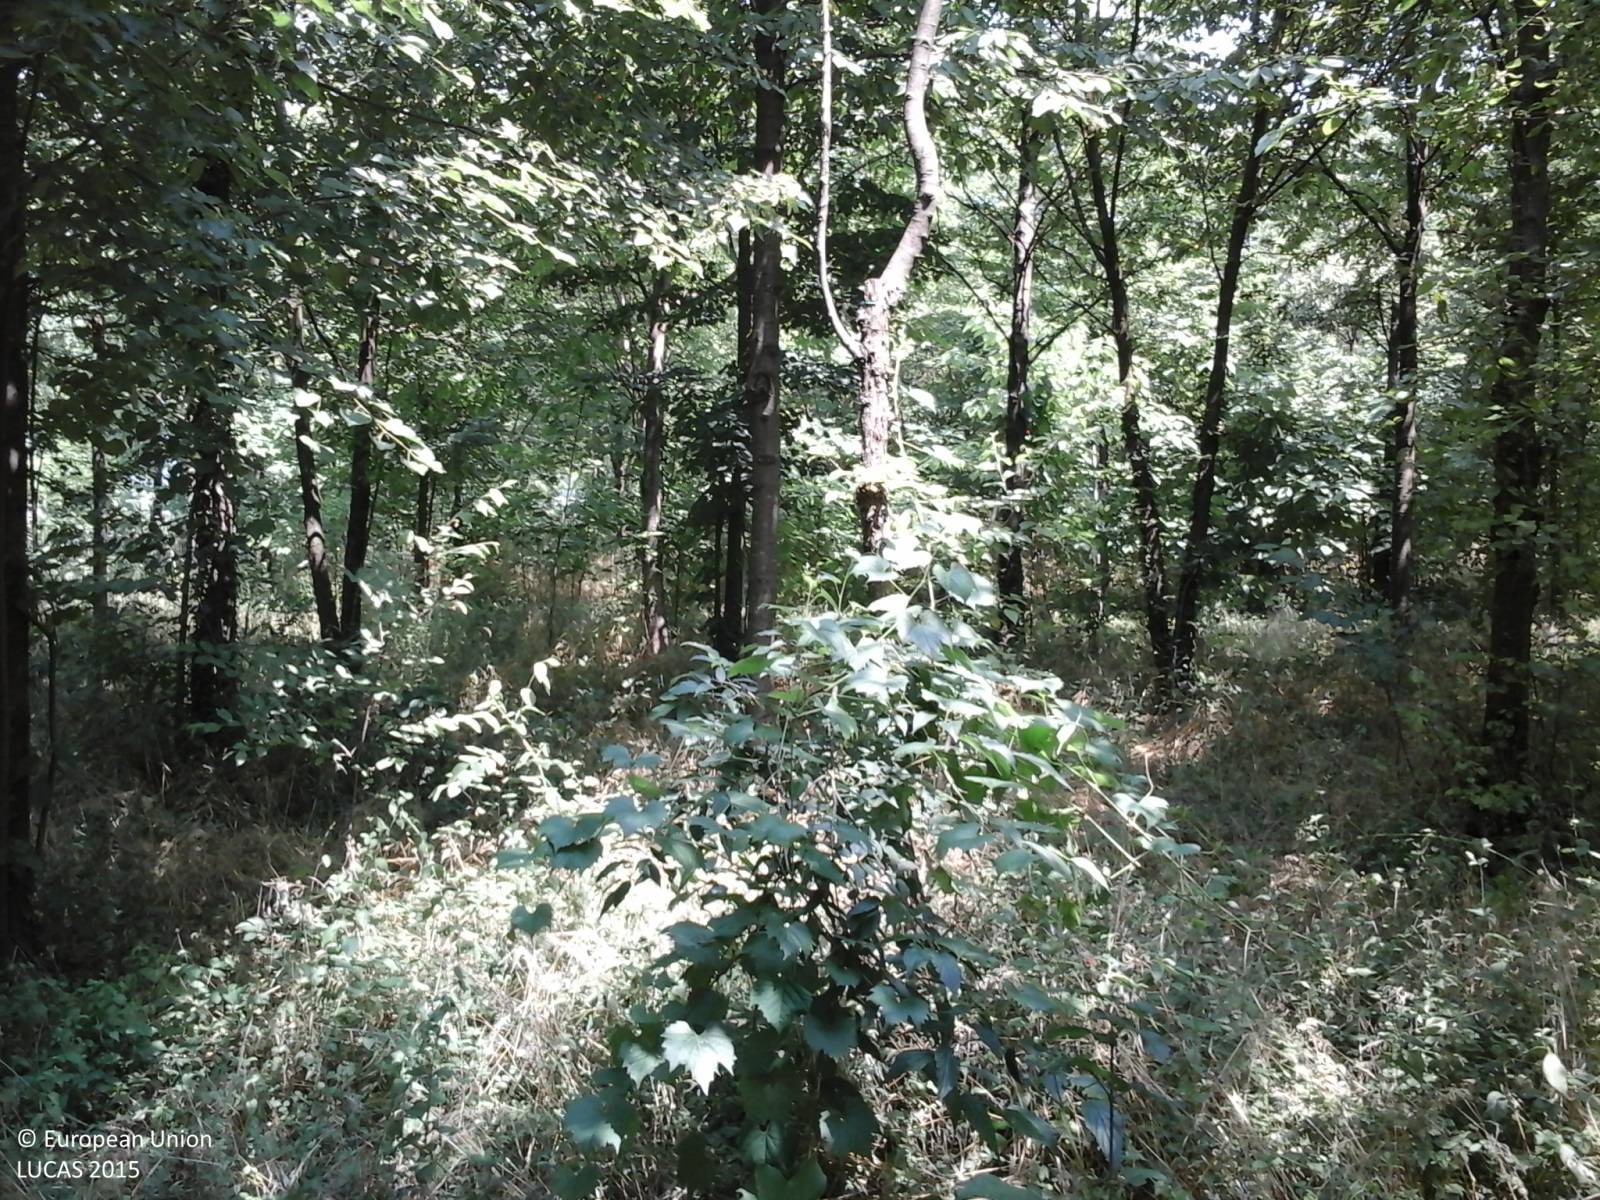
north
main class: Woodland
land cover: Broadleaved woodland
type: mesophytic deciduous forest
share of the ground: > 75 %
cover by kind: broadleaved forest trees 100 %
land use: Forestry
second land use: Agriculture (excluding fallow land and kitchen gardens)
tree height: > 5 m
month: June
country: IT
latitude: 46.0147
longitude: 12.5412
